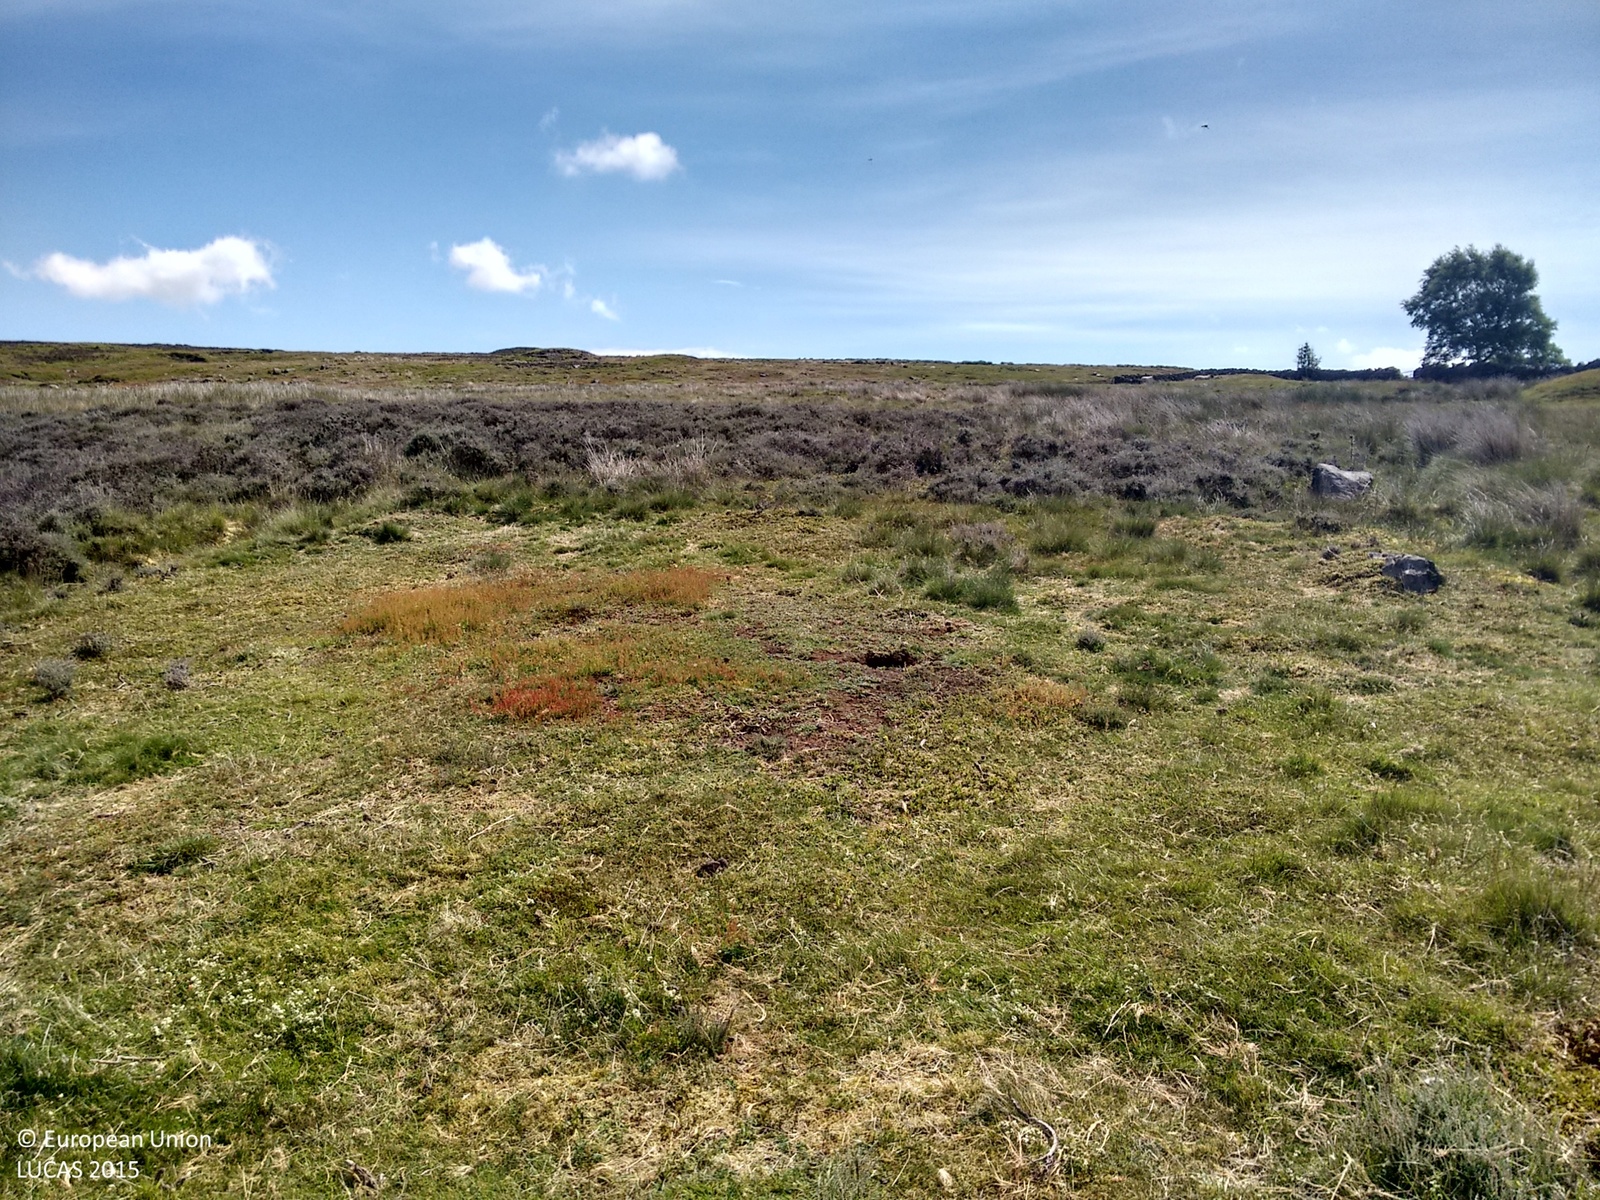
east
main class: Shrubland
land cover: Shrubland without tree cover
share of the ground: > 75 %
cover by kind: shrubs 60 %, herbaceous plants 40 %
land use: Agriculture (excluding fallow land and kitchen gardens)
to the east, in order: Shrubland without tree cover; Ditches and canals; Shrubland without tree cover; Tracks; Shrubland without tree cover
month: July
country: GB
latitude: 54.4703
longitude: -0.8878
